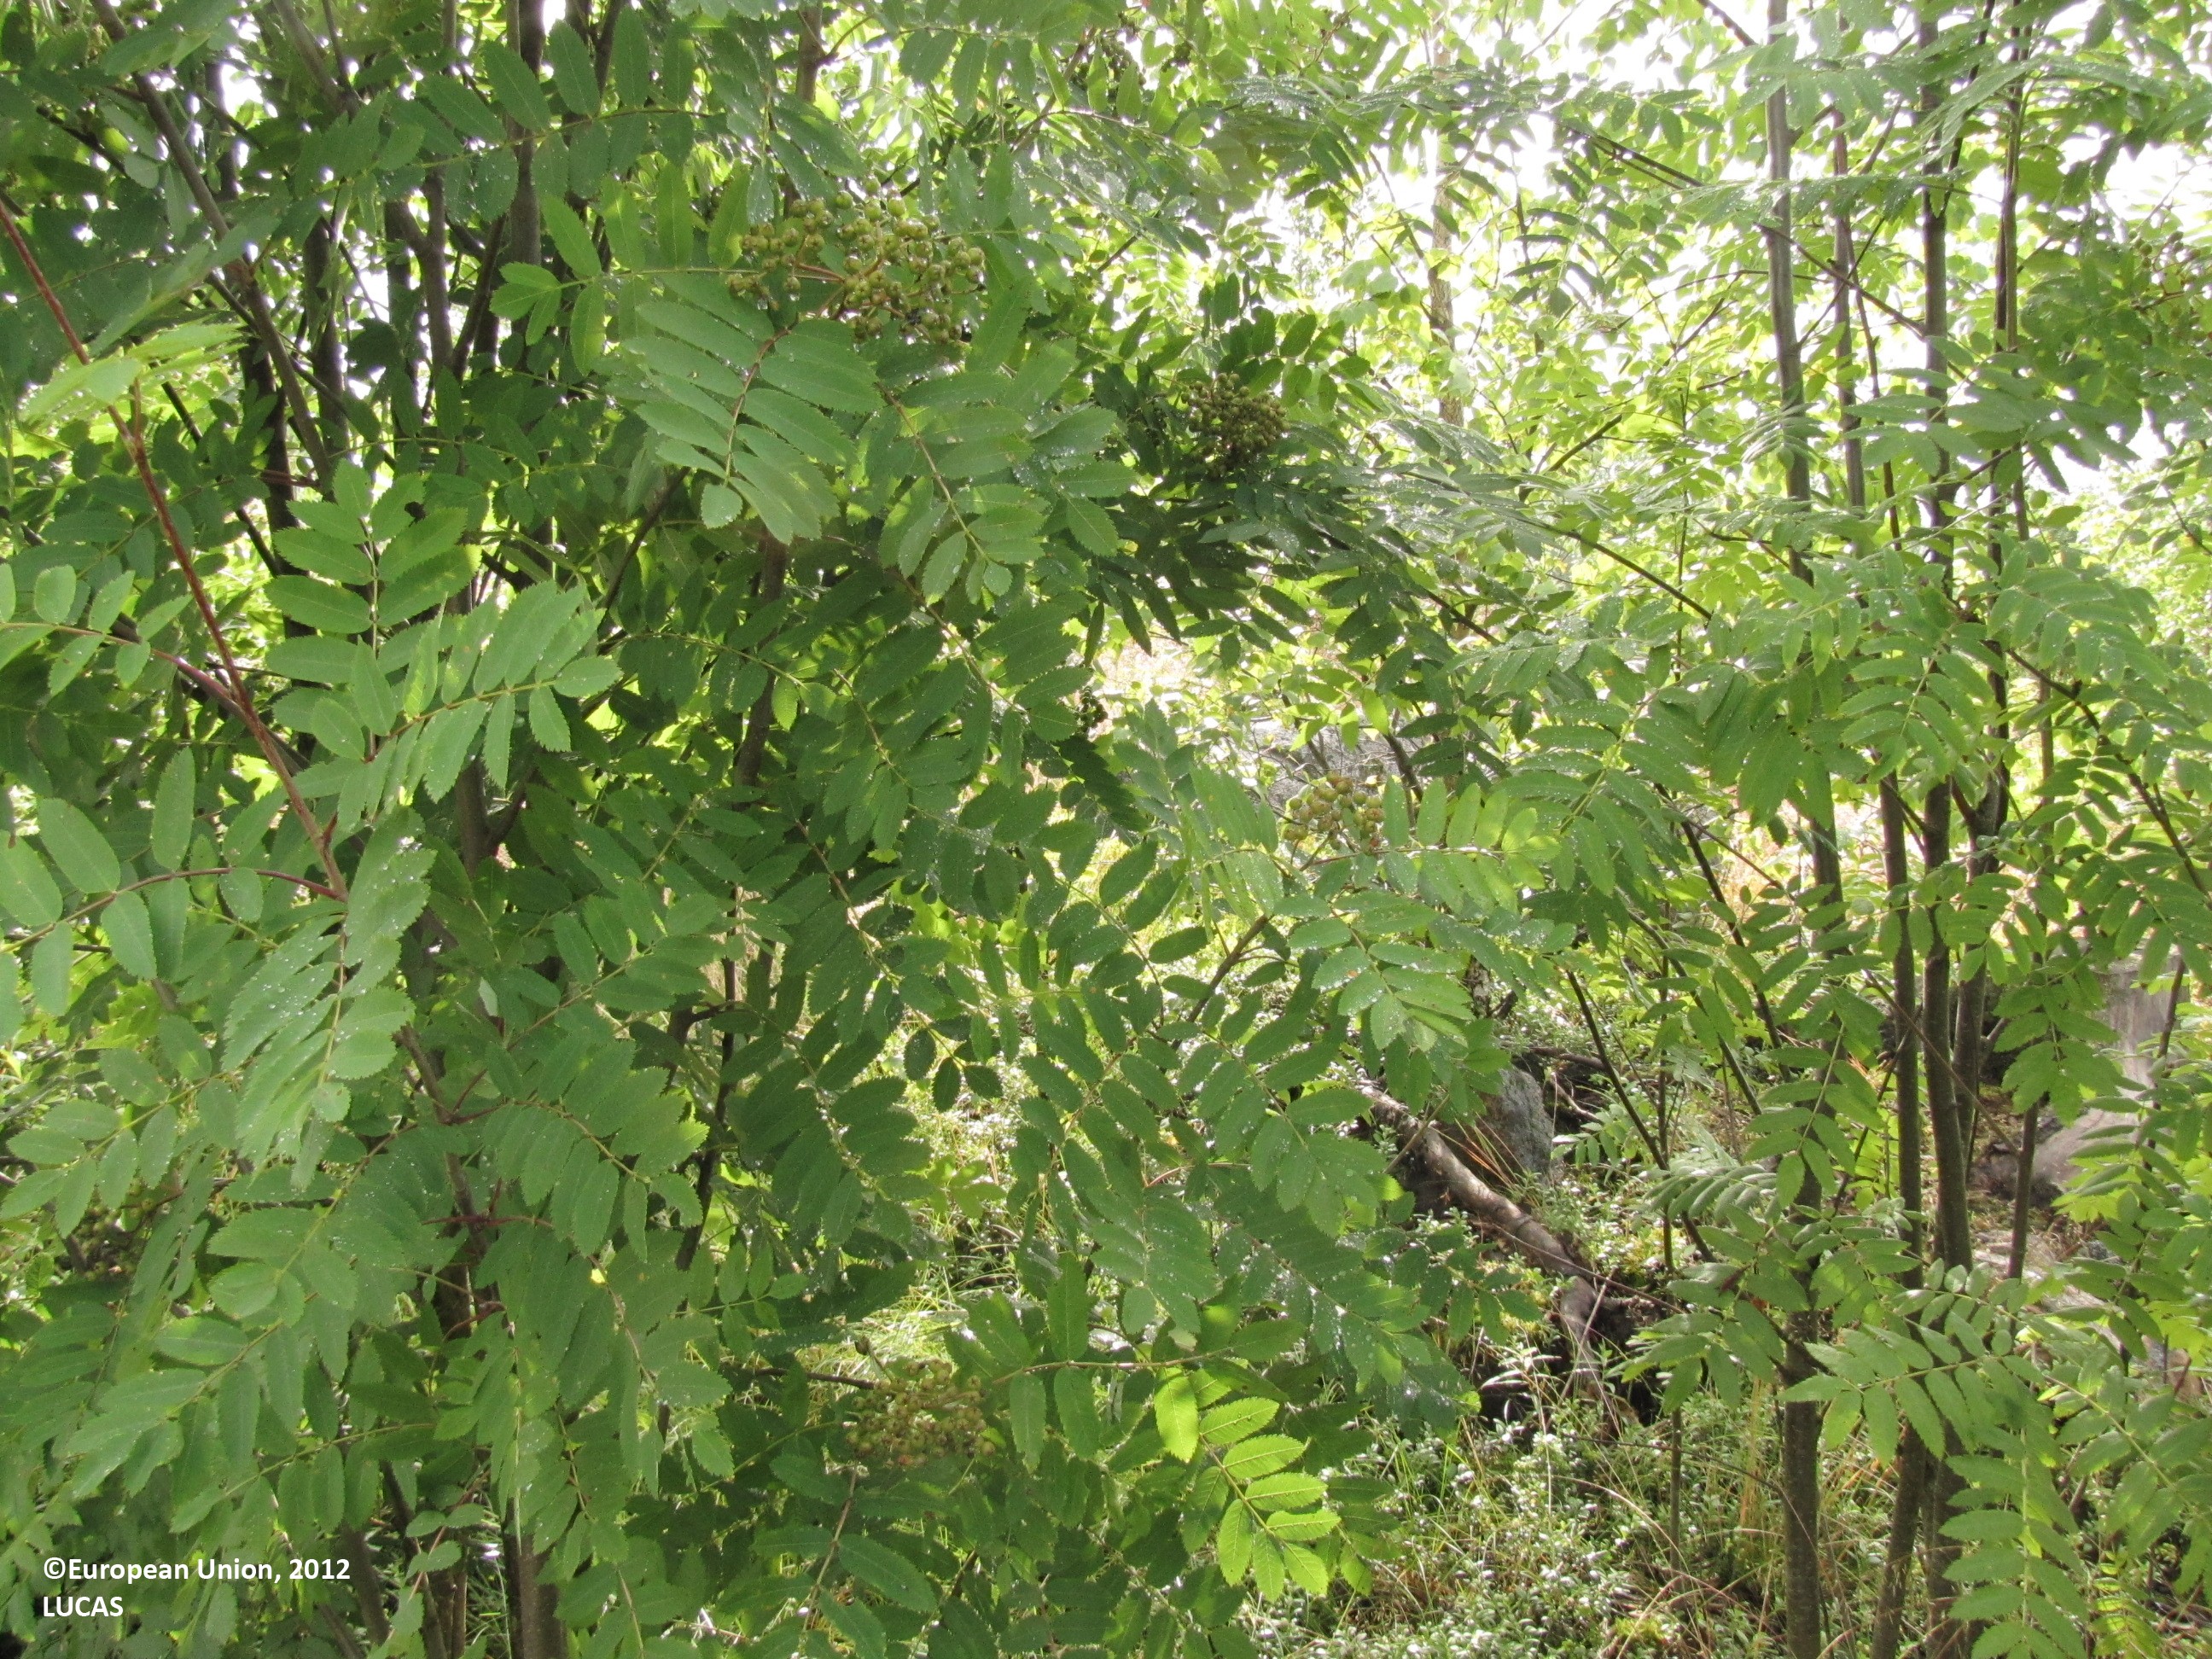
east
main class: Woodland
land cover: Broadleaved woodland
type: boreal forest
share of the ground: 50 - 75 %
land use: Forestry
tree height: < 5 m
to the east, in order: Broadleaved woodland; Pine dominated coniferous woodland; Abandoned hedges; Ditches and canals; Tracks; Ditches and canals; Other mixed woodland; Ditches and canals; Temporary grasslands
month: July
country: FI
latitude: 62.1540
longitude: 23.0199
